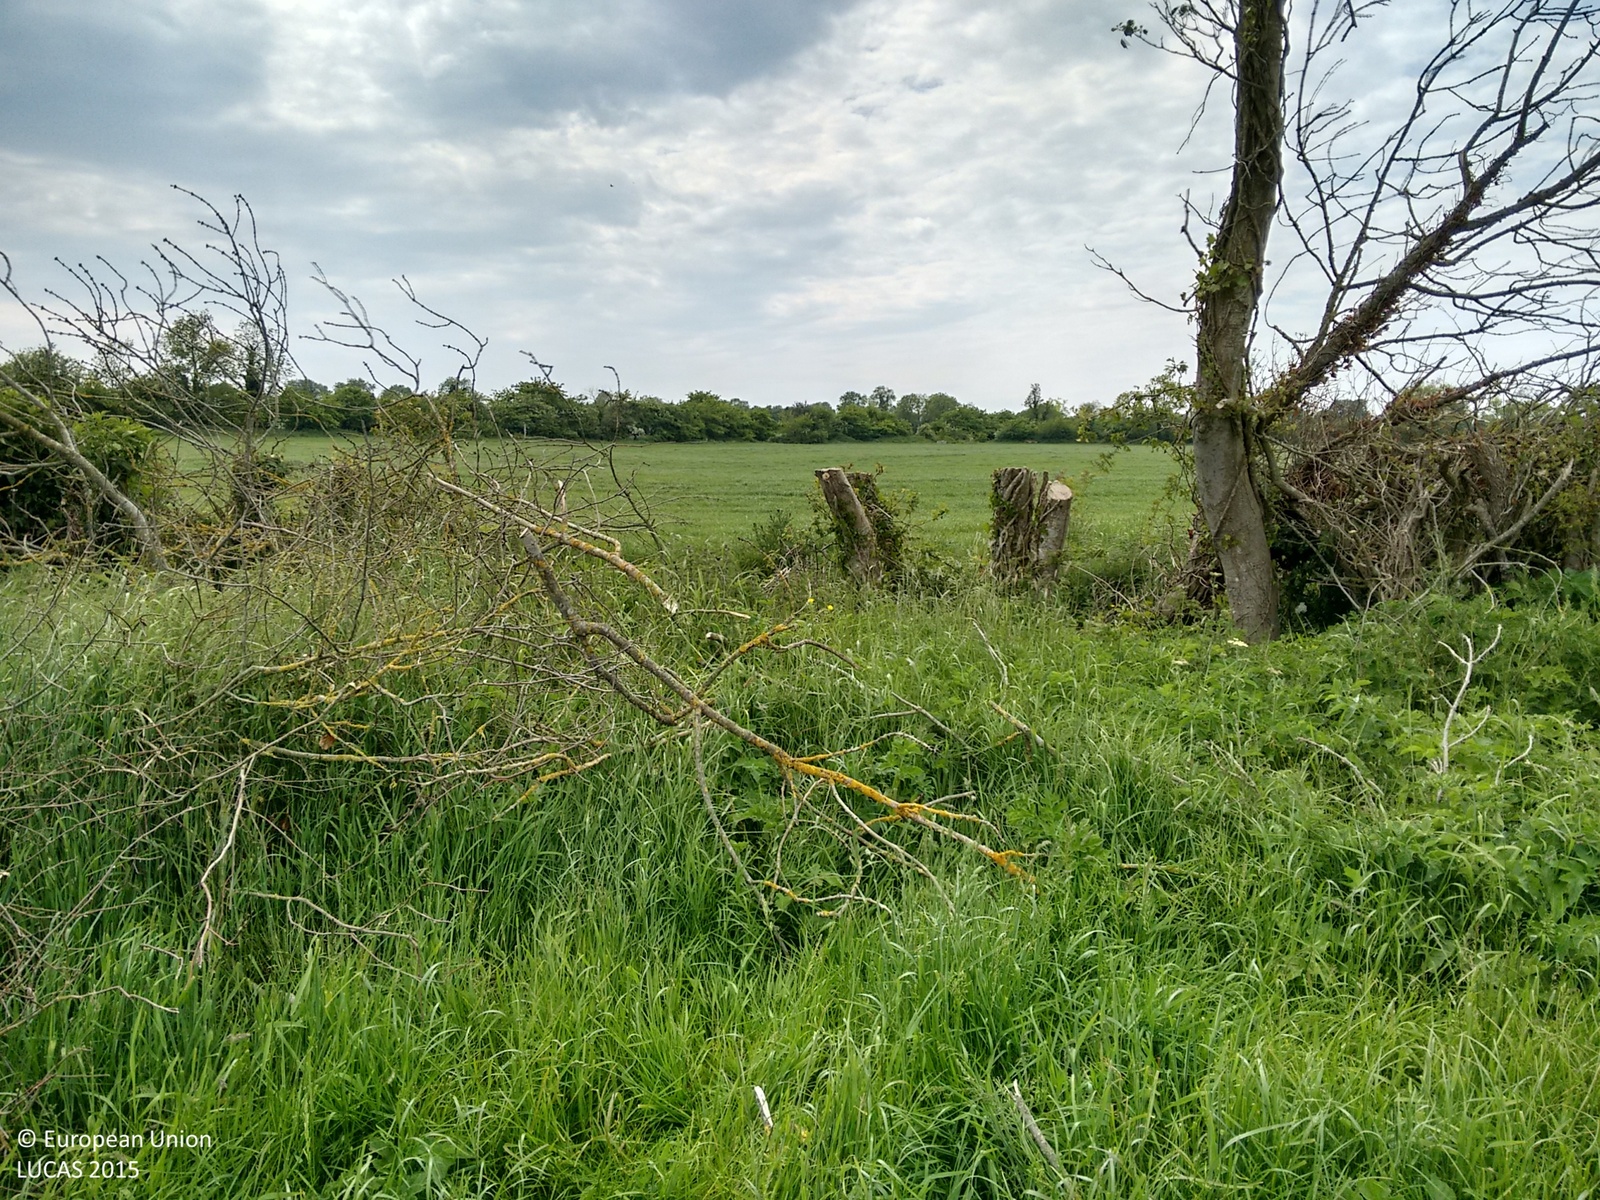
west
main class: Grassland
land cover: Grassland without tree/shrub cover
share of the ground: > 75 %
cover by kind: herbaceous plants 95 %, unconsolidated bare surface 5 %
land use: Agriculture (excluding fallow land and kitchen gardens)
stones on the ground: < 10 %
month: June
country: IE
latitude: 53.5583
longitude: -6.5372
